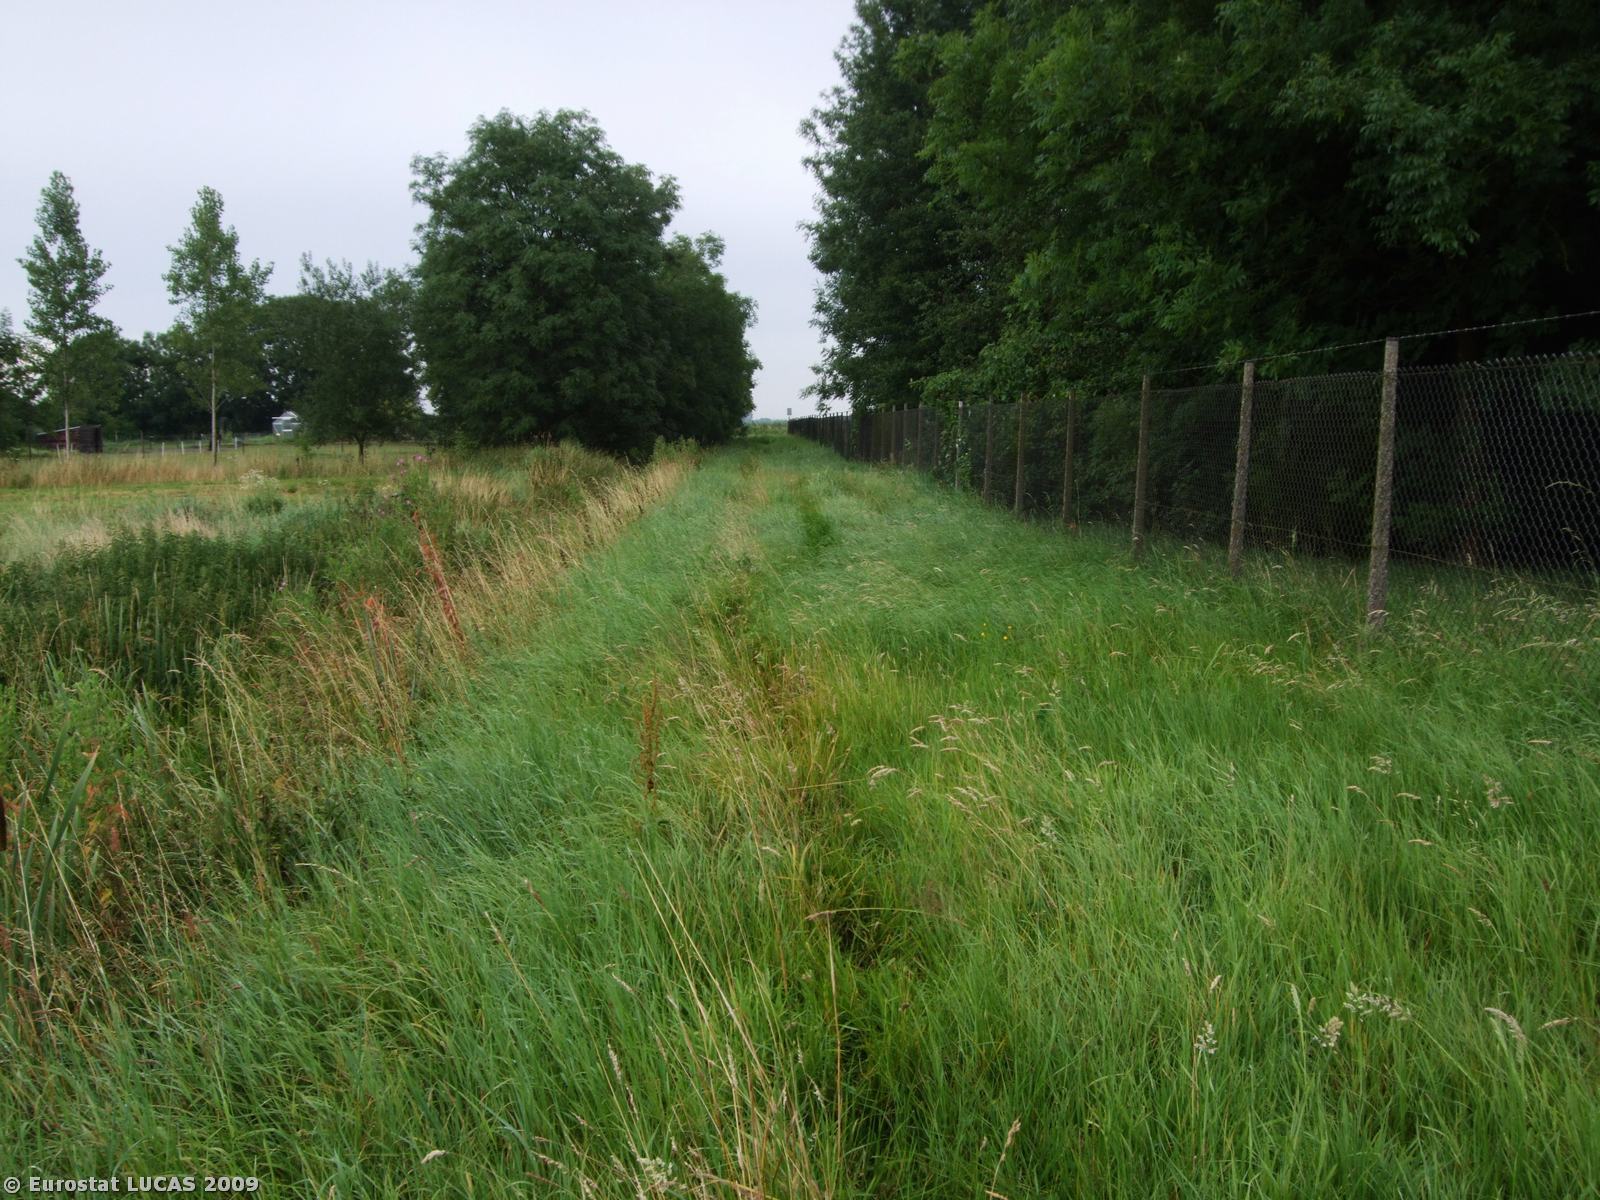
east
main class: Grassland
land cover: Grassland without tree/shrub cover
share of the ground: > 75 %
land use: Agriculture (excluding fallow land and kitchen gardens)
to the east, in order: Grassland without tree/shrub cover; Fences; Grassland without tree/shrub cover; Broadleaved woodland; Grassland without tree/shrub cover; Artificial constructions in urban areas; Grass margins; Paved roads, cycling and walking lanes; Grass margins; Ditches and canals; Grass margins; Maize
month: July
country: NL
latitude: 51.7844
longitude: 5.4028
